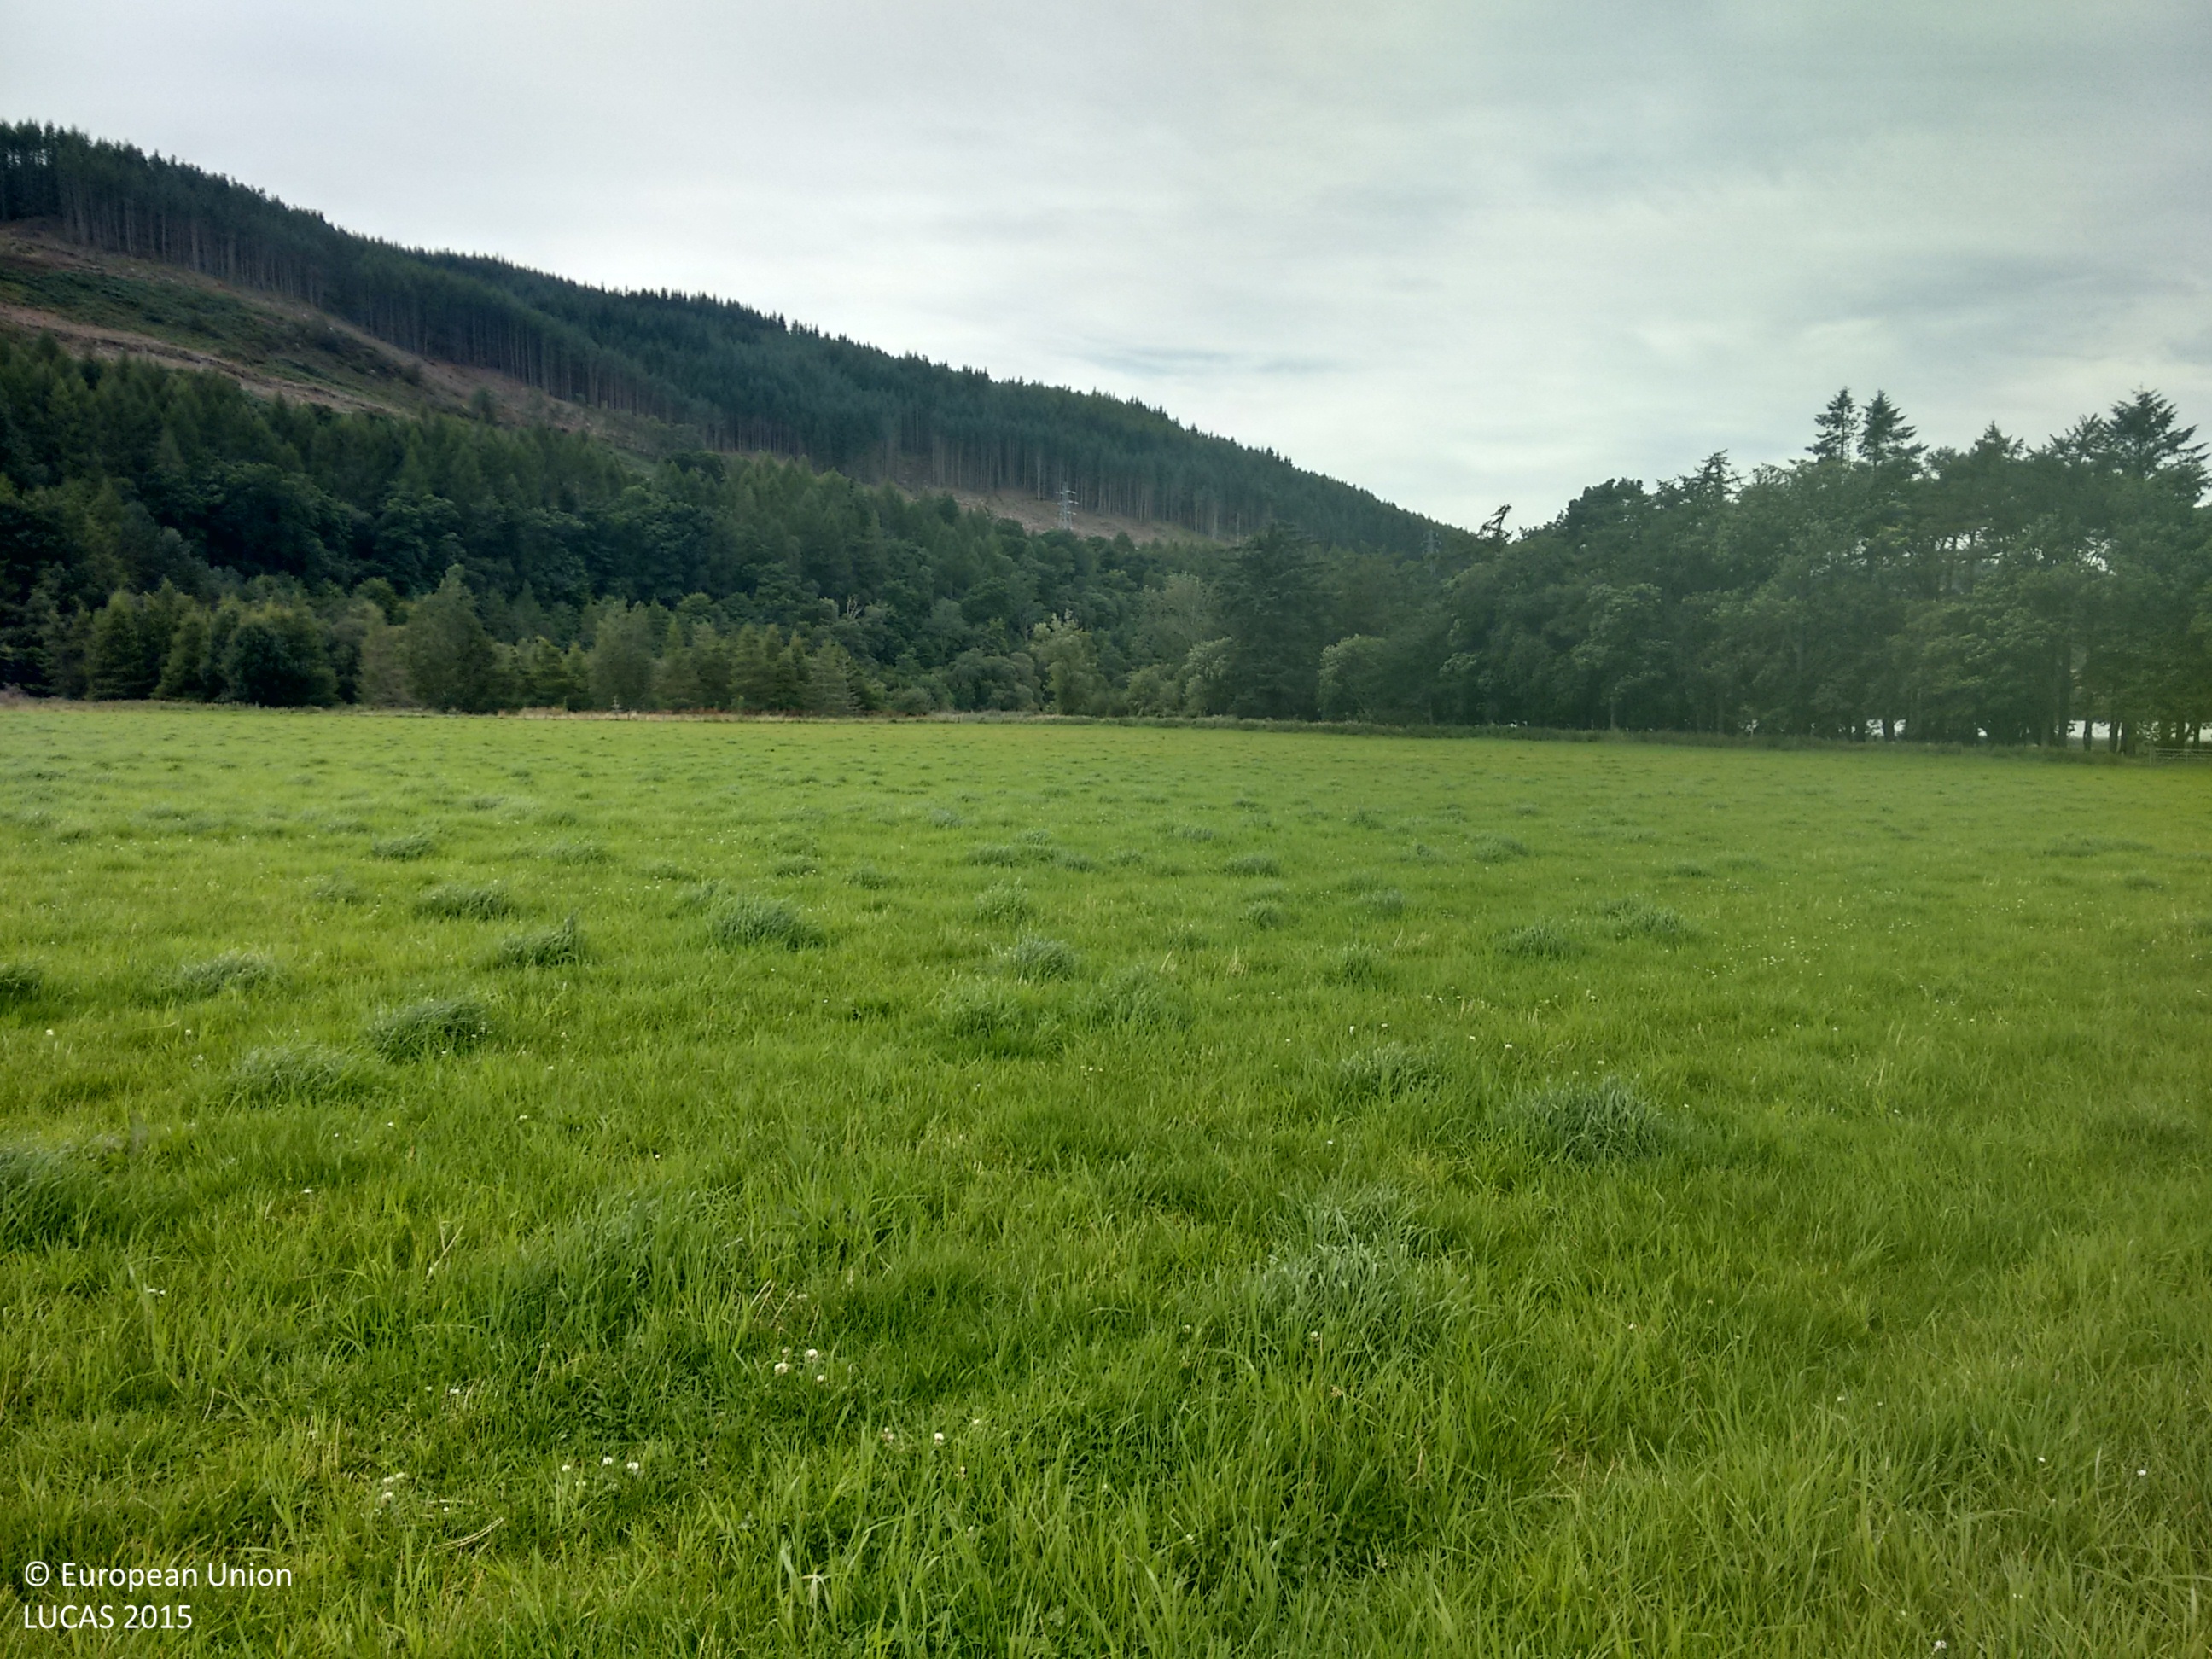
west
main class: Grassland
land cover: Grassland without tree/shrub cover
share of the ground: > 75 %
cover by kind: herbaceous plants 100 %
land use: Agriculture (excluding fallow land and kitchen gardens)
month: September
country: GB
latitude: 57.8532
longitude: -4.2893
